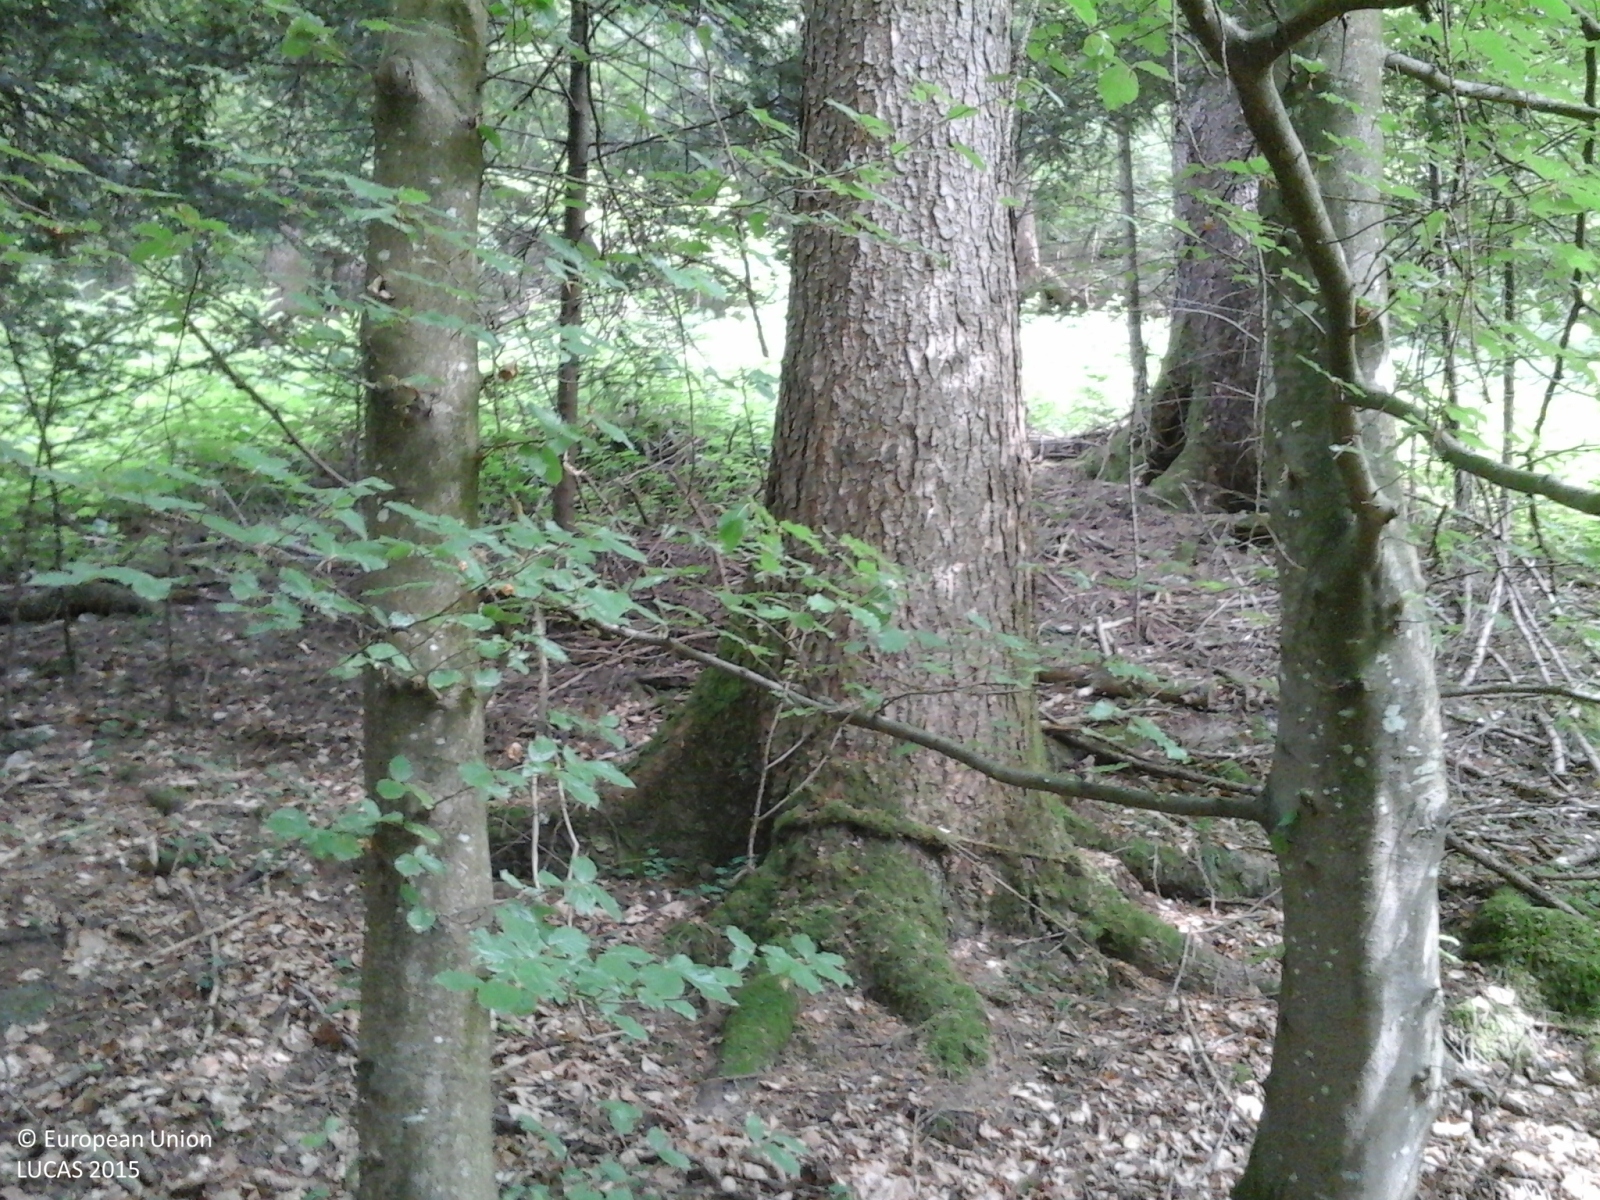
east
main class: Woodland
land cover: Other coniferous woodland
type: alpine coniferous forest
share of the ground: > 75 %
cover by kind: coniferous forest trees 95 %, broadleaved forest trees 5 %
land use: Forestry
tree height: > 5 m
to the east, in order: Other coniferous woodland; Tracks; Other coniferous woodland
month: June
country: IT
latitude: 45.9876
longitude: 10.8379
